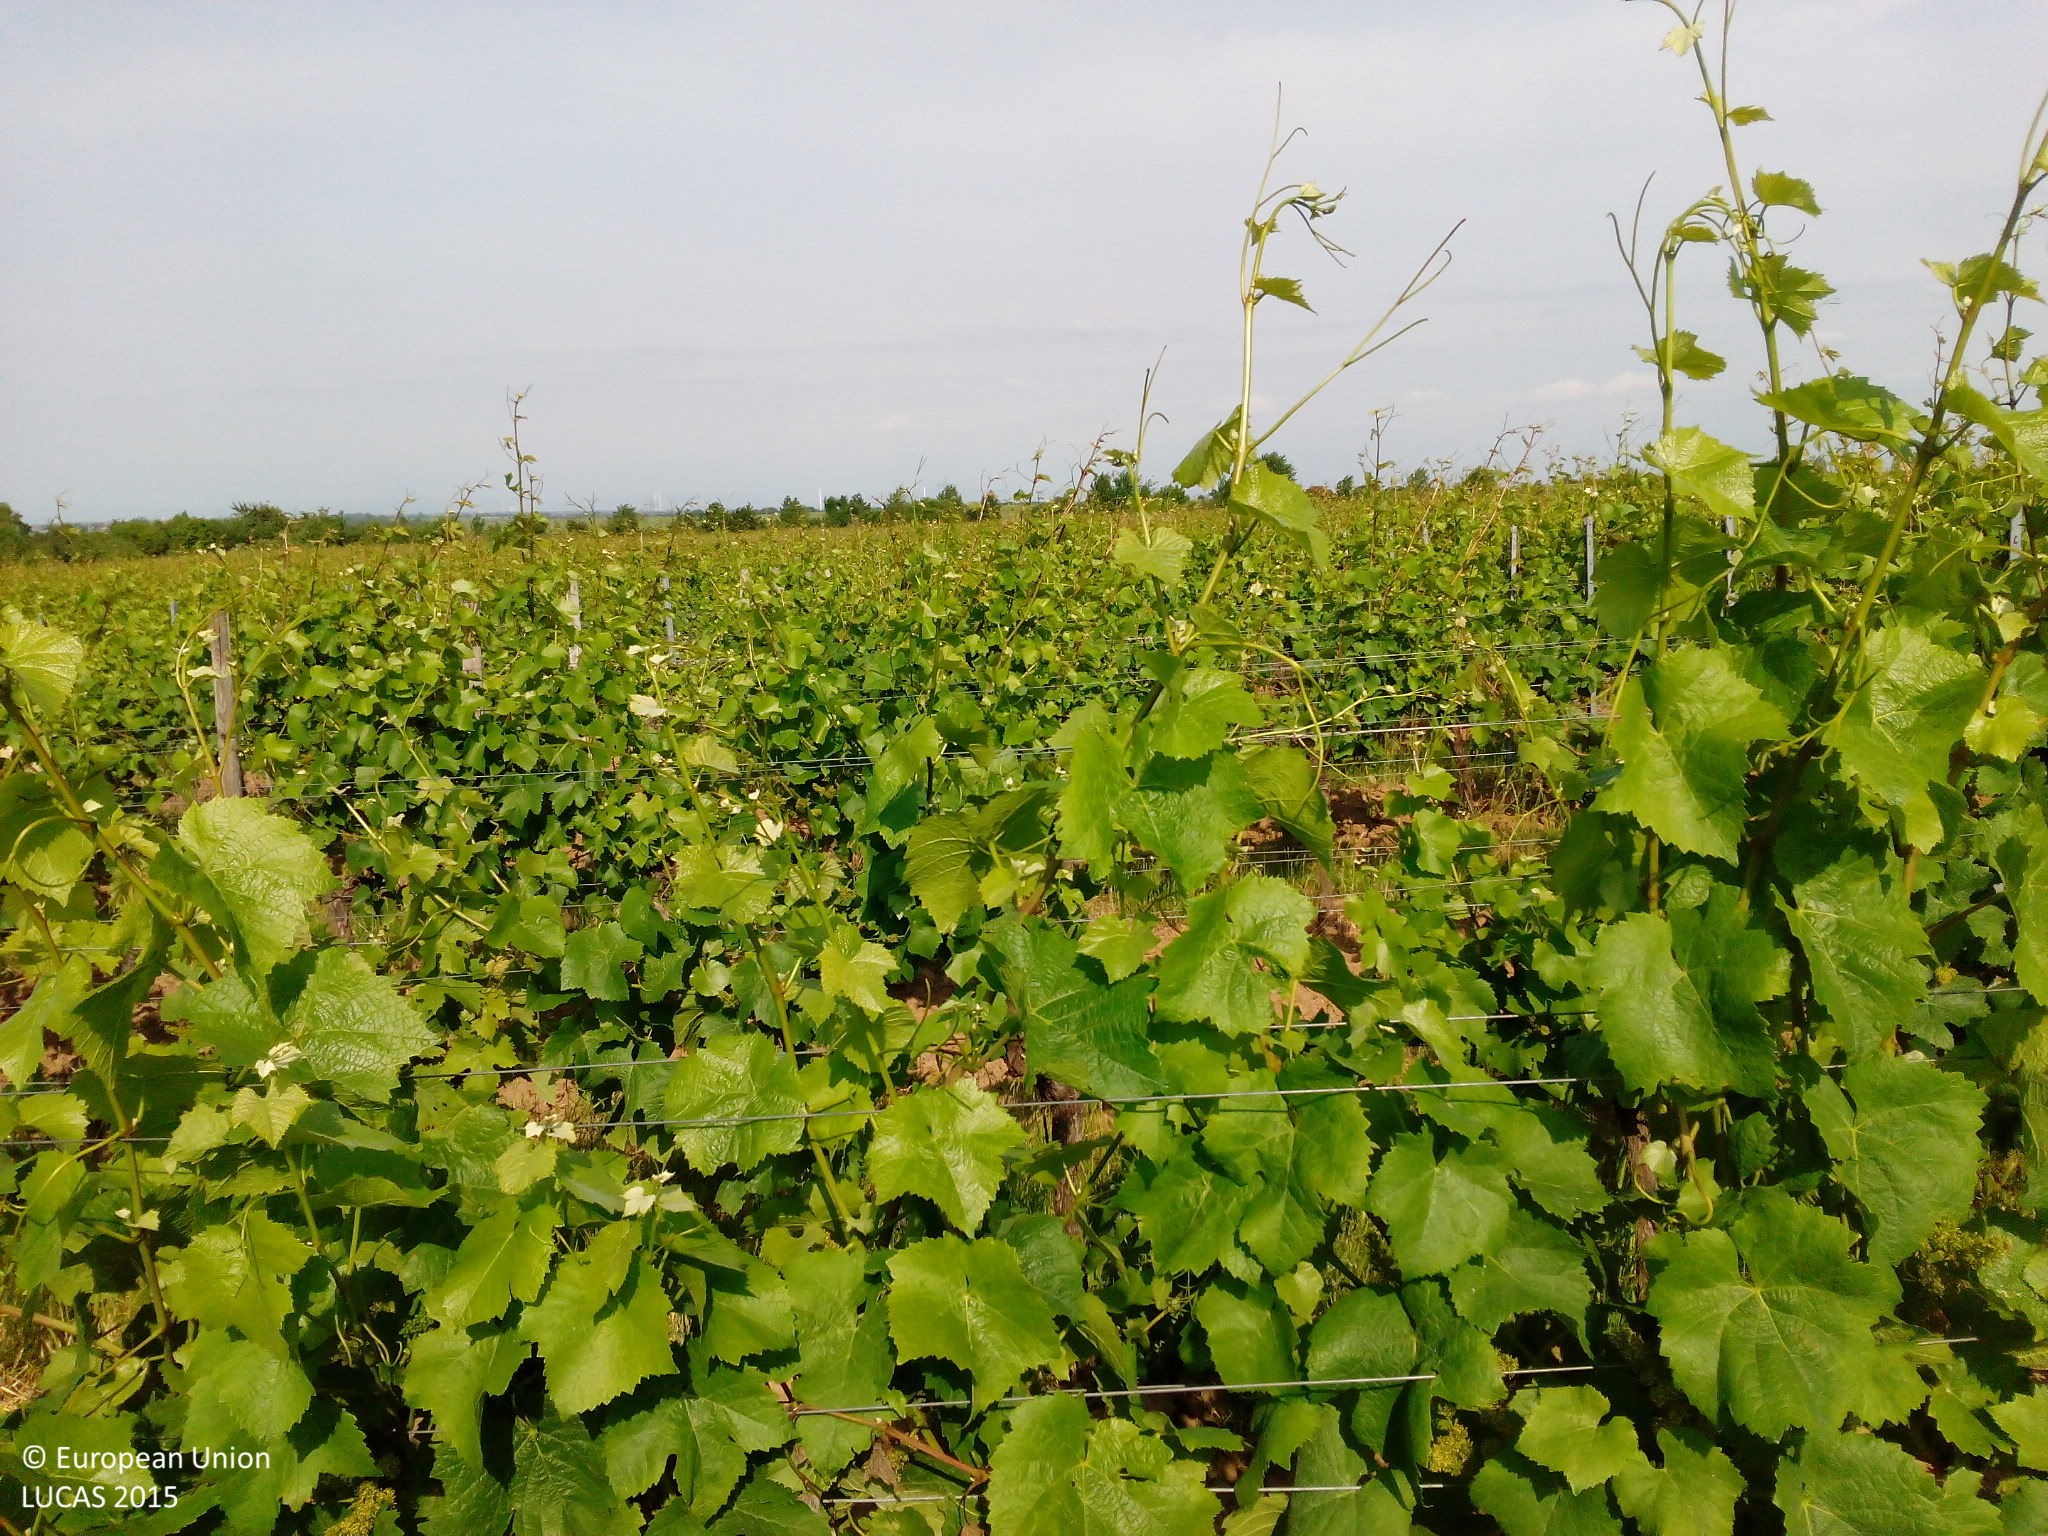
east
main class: Cropland
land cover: Vineyards
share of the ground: 10 - 25 %
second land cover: Grassland without tree/shrub cover
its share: 25 - 50 %
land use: Agriculture (excluding fallow land and kitchen gardens)
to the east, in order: Vineyards; Grassland without tree/shrub cover; Tracks; Grassland with sparse tree/shrub cover; Railways; Abandoned hedges; Tracks; Vineyards
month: June
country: DE
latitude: 49.3780
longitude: 8.1686
